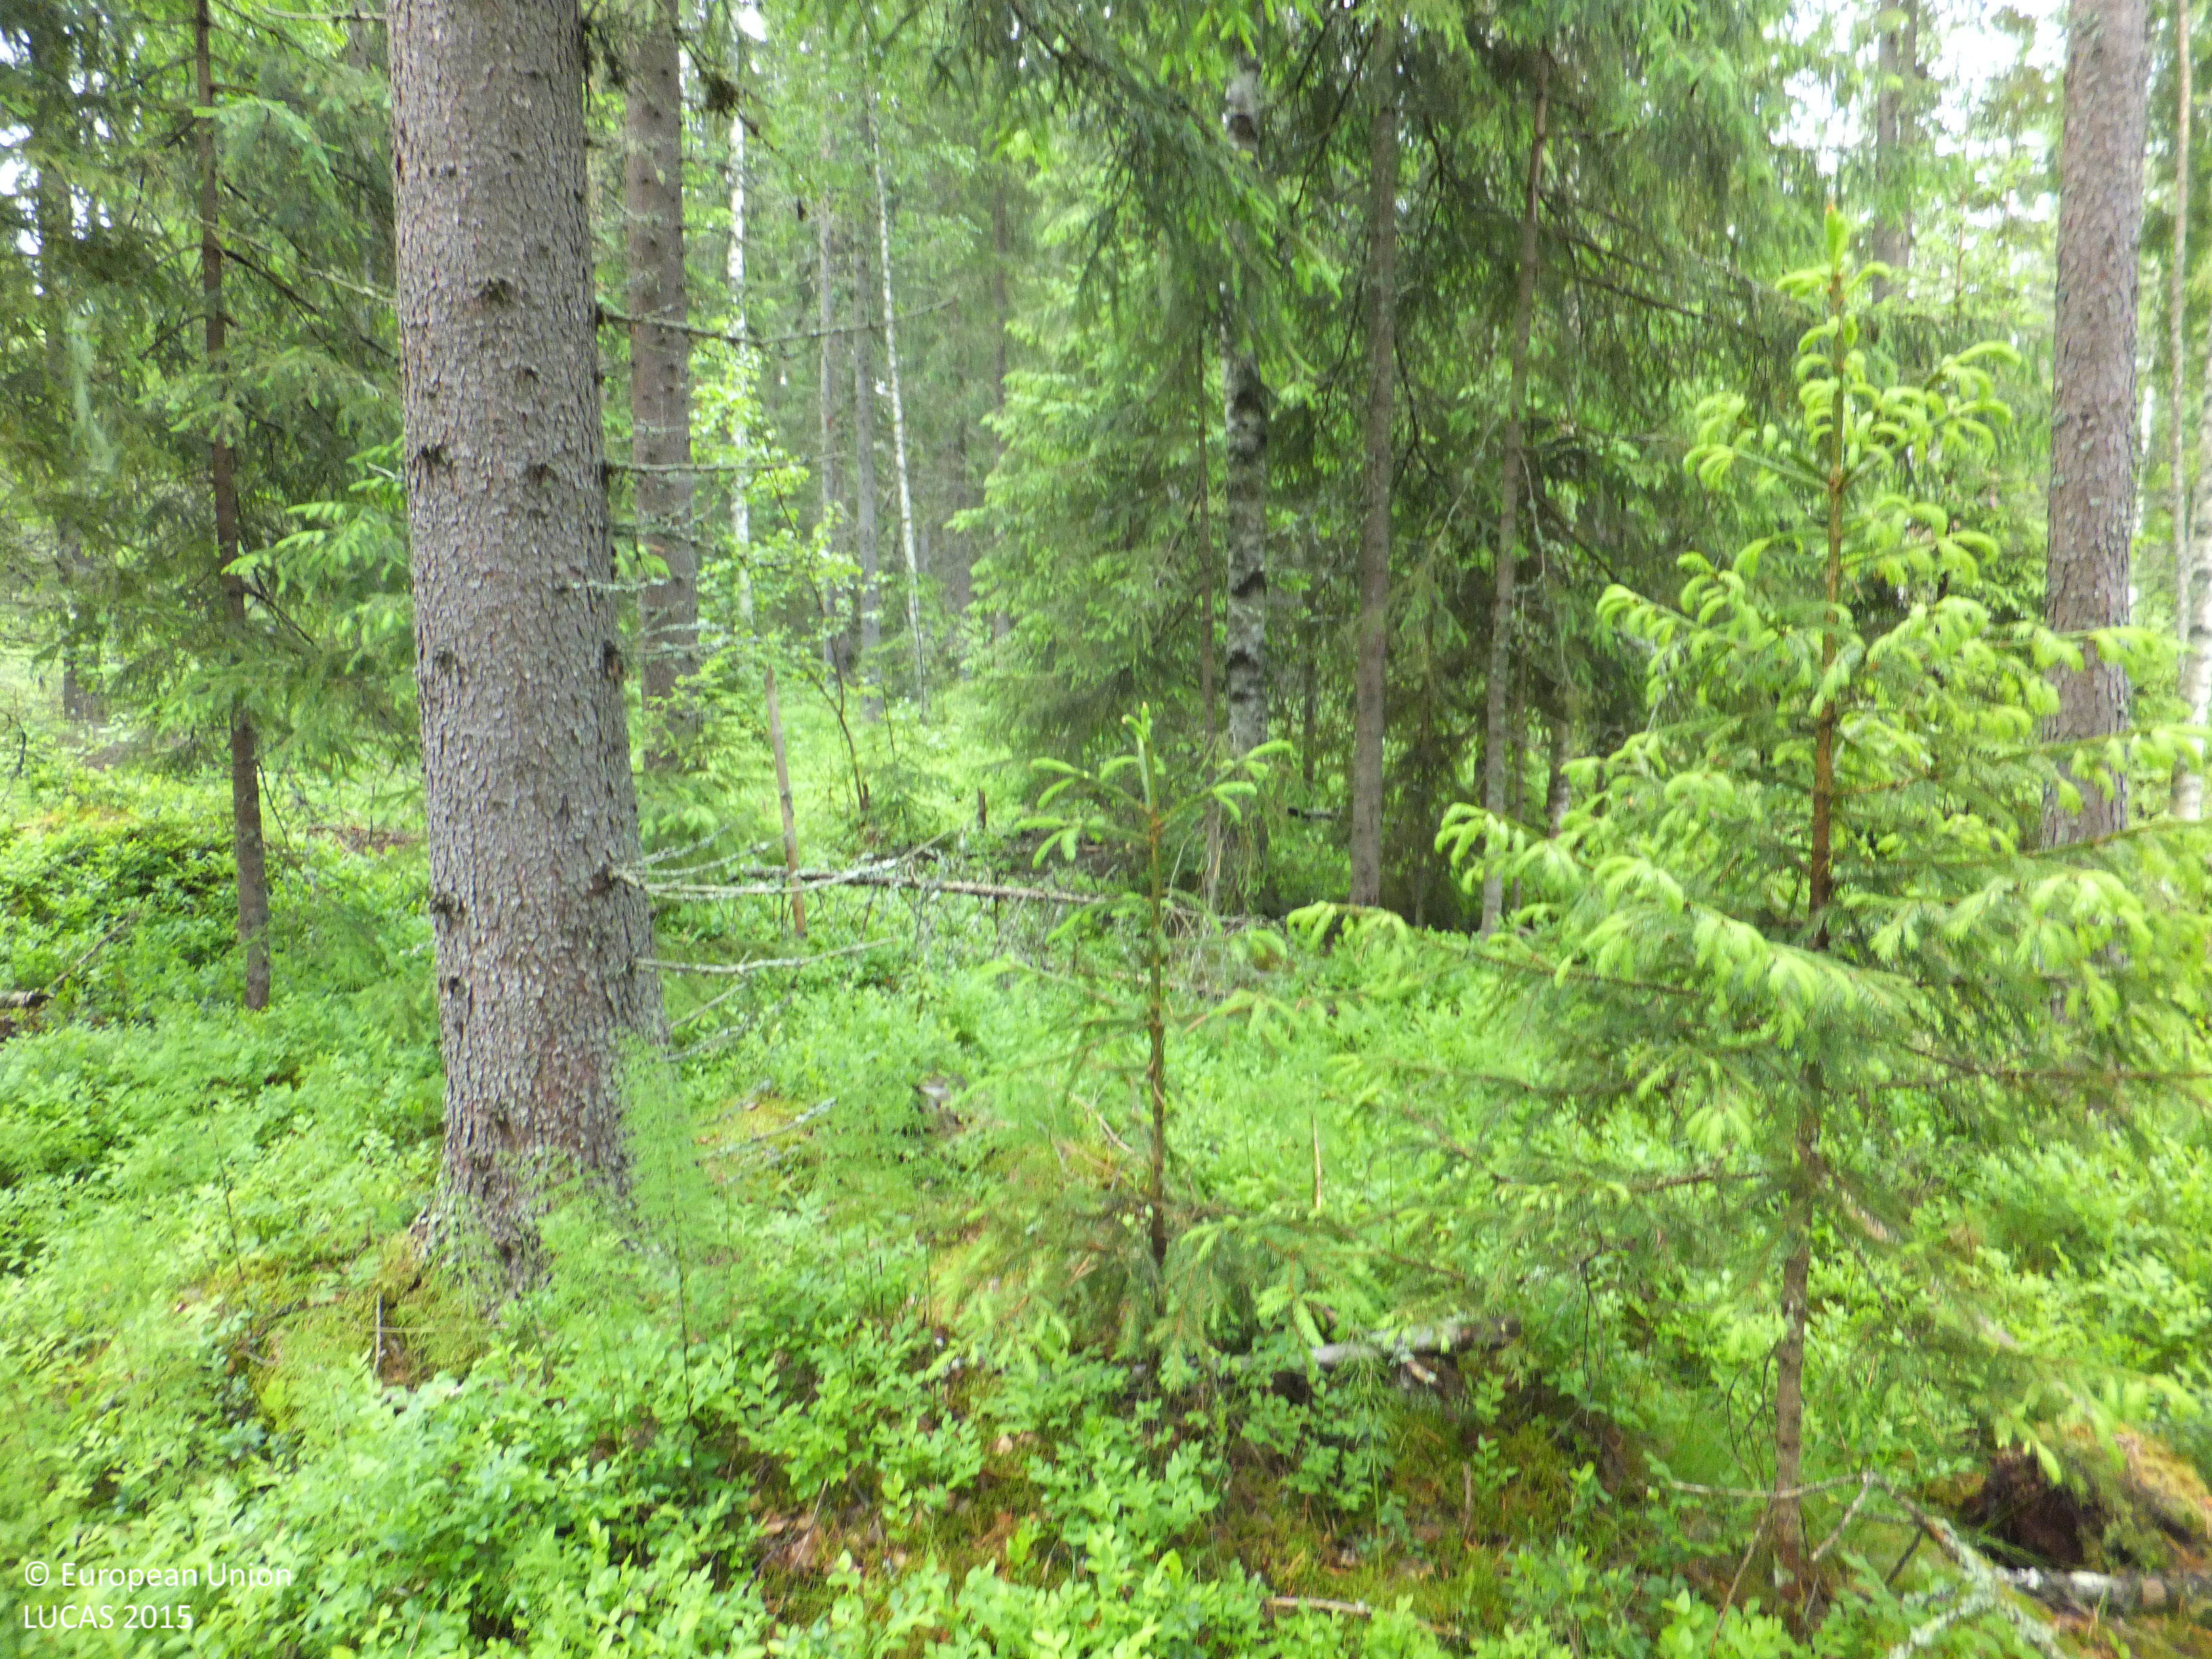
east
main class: Woodland
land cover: Other mixed woodland
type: boreal forest
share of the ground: > 75 %
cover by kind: coniferous forest trees 50 %, broadleaved forest trees 25 %, shrubs 15 %, lichens and mosses 10 %
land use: Forestry
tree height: > 5 m
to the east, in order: Other mixed woodland; Spruce dominated mixed woodland; Ditches and canals; Spruce dominated mixed woodland; Shrubland with sparse tree cover; Spruce dominated mixed woodland; Spruce dominated coniferous woodland; Tracks; Other coniferous woodland; Spruce dominated coniferous woodland; Other coniferous woodland
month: June
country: FI
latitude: 63.4316
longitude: 23.9173
